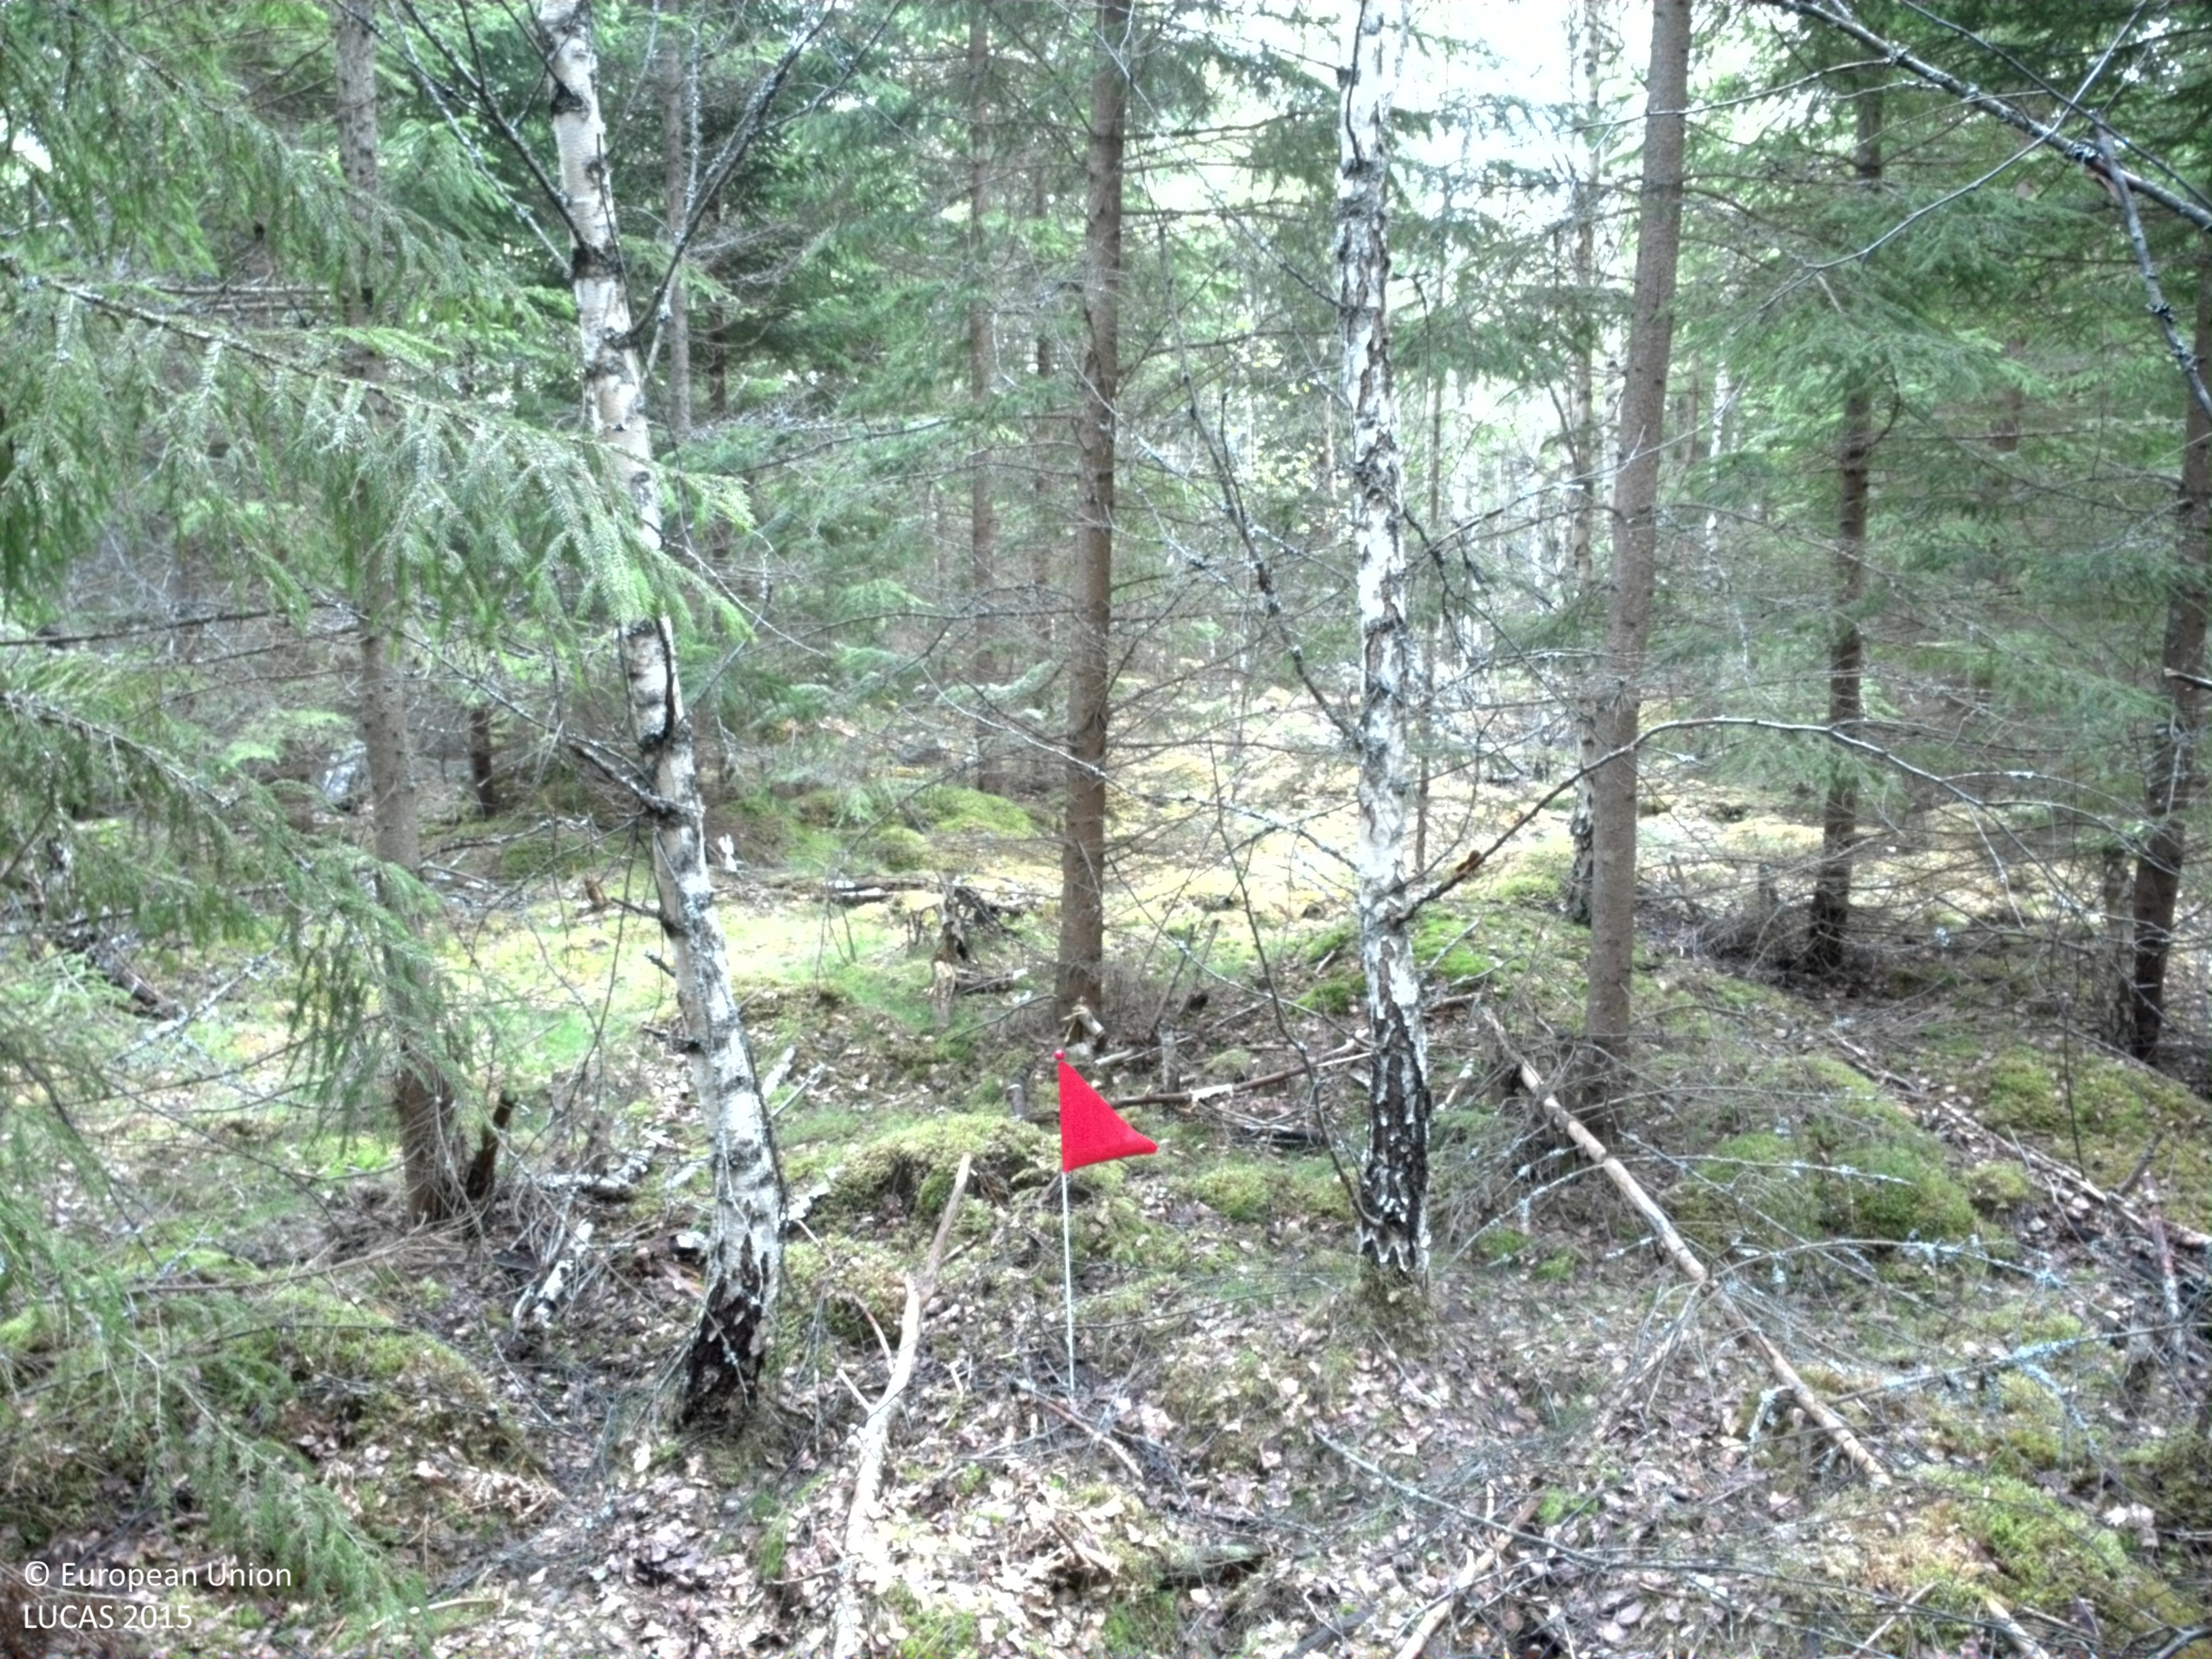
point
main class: Woodland
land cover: Spruce dominated mixed woodland
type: boreal forest
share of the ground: > 75 %
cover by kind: coniferous forest trees 40 %, broadleaved forest trees 40 %, lichens and mosses 20 %
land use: Forestry
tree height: > 5 m
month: May
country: SE
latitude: 56.7717
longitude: 15.0865
